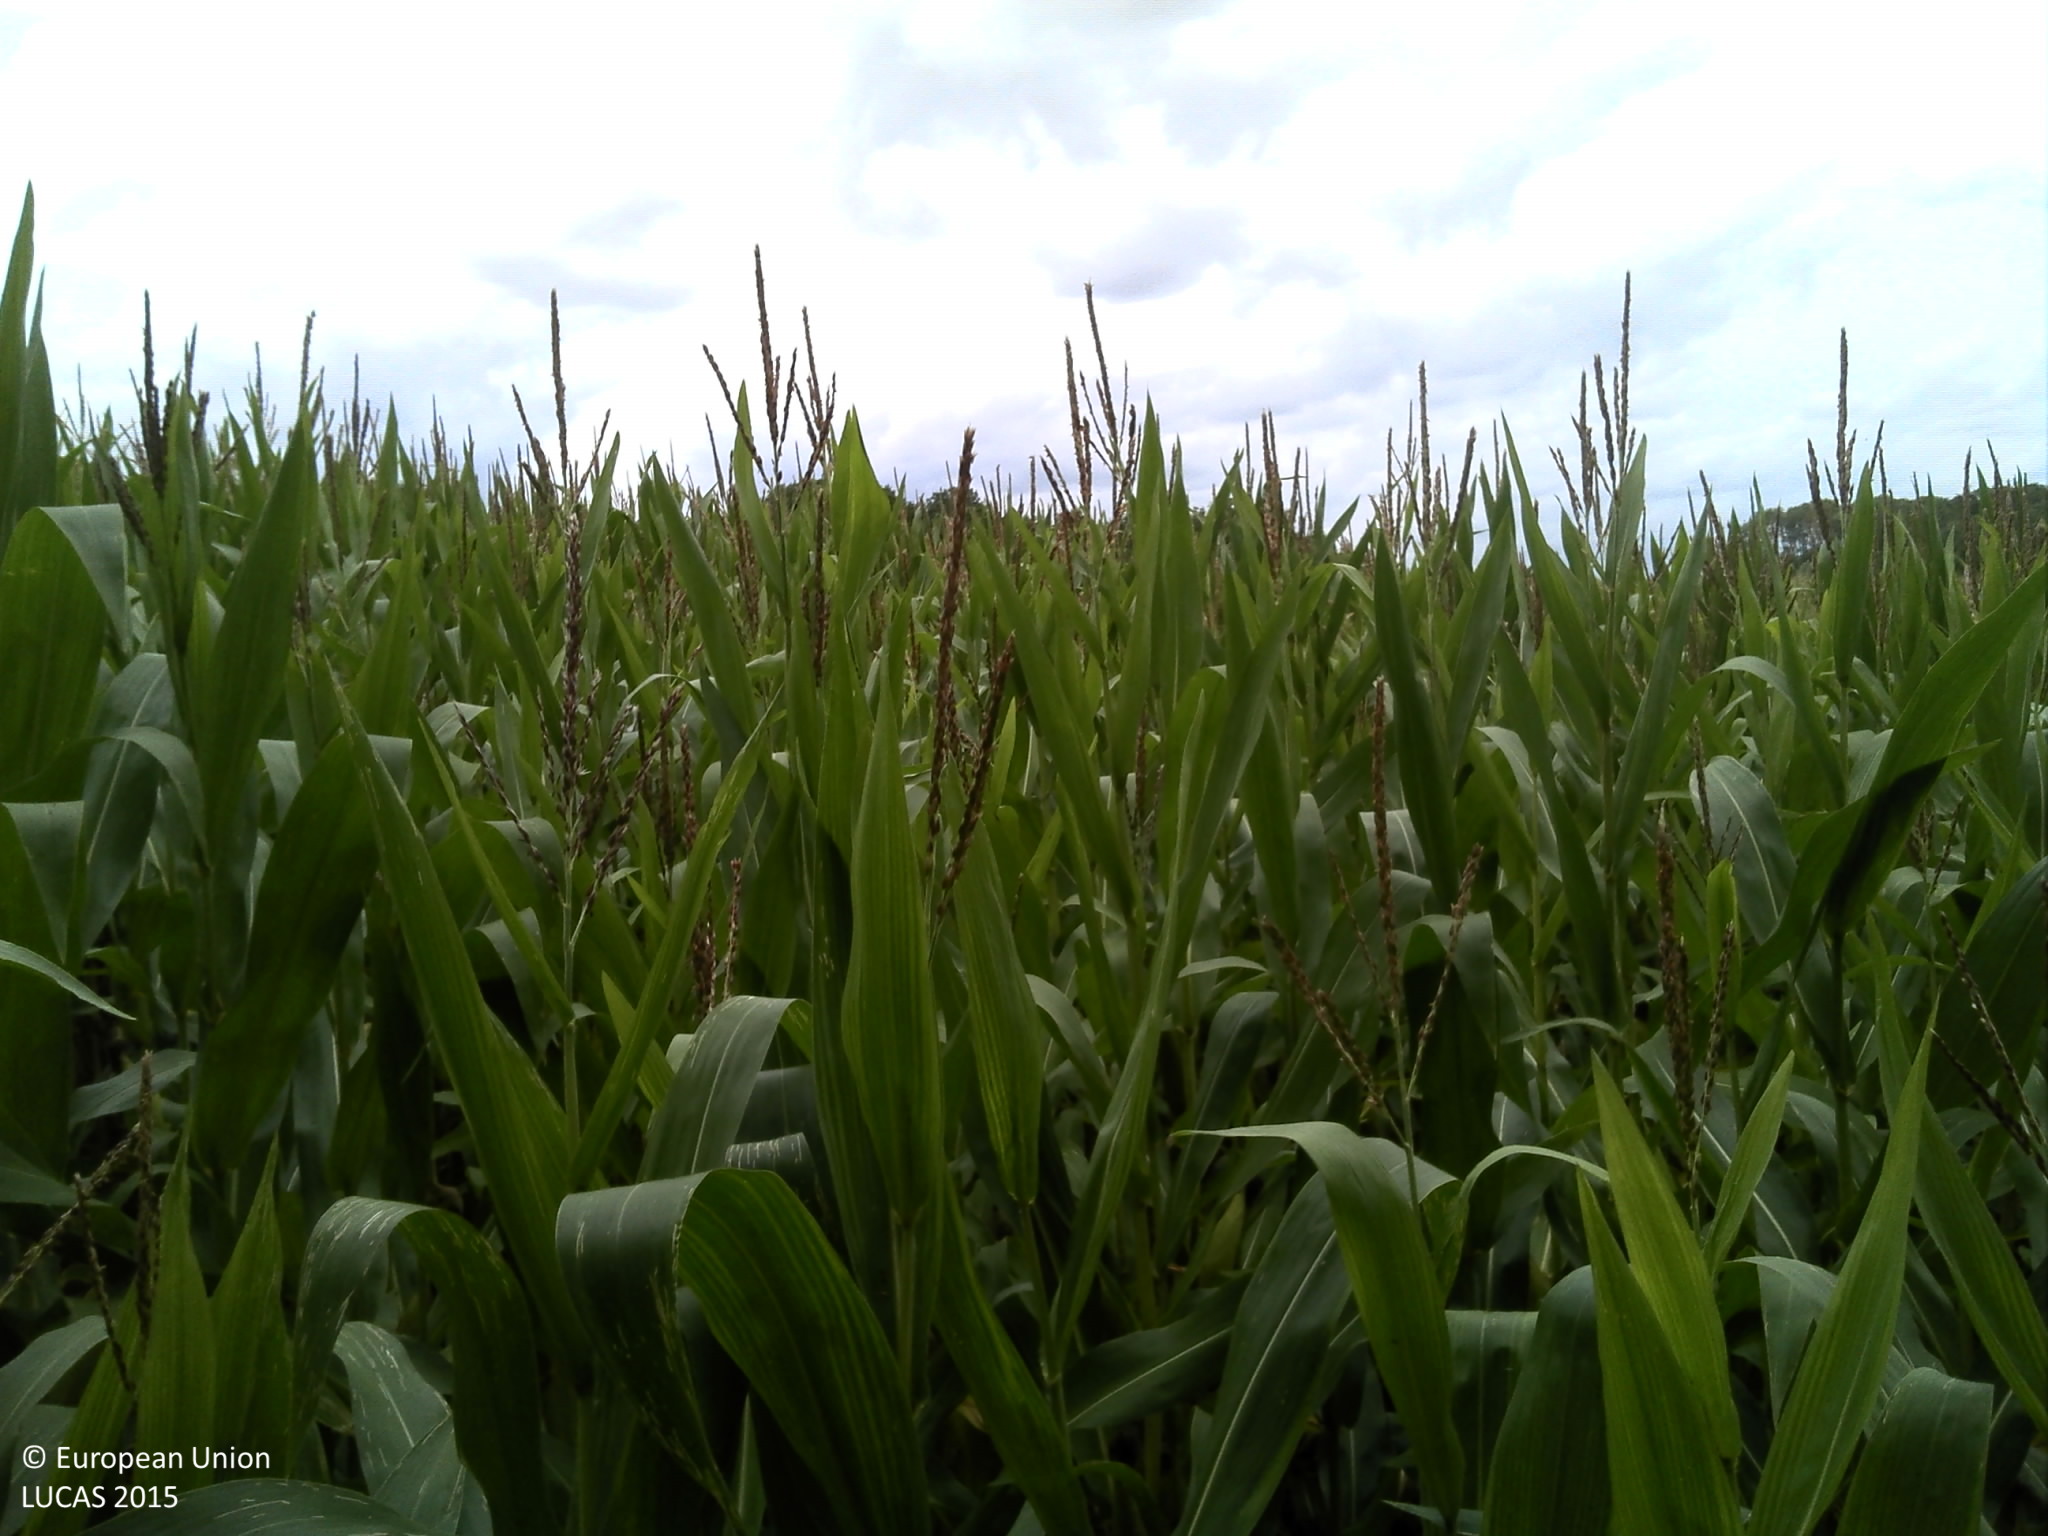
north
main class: Cropland
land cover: Maize
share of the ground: > 75 %
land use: Agriculture (excluding fallow land and kitchen gardens)
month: July
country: FR
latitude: 49.5830
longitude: 4.1444
